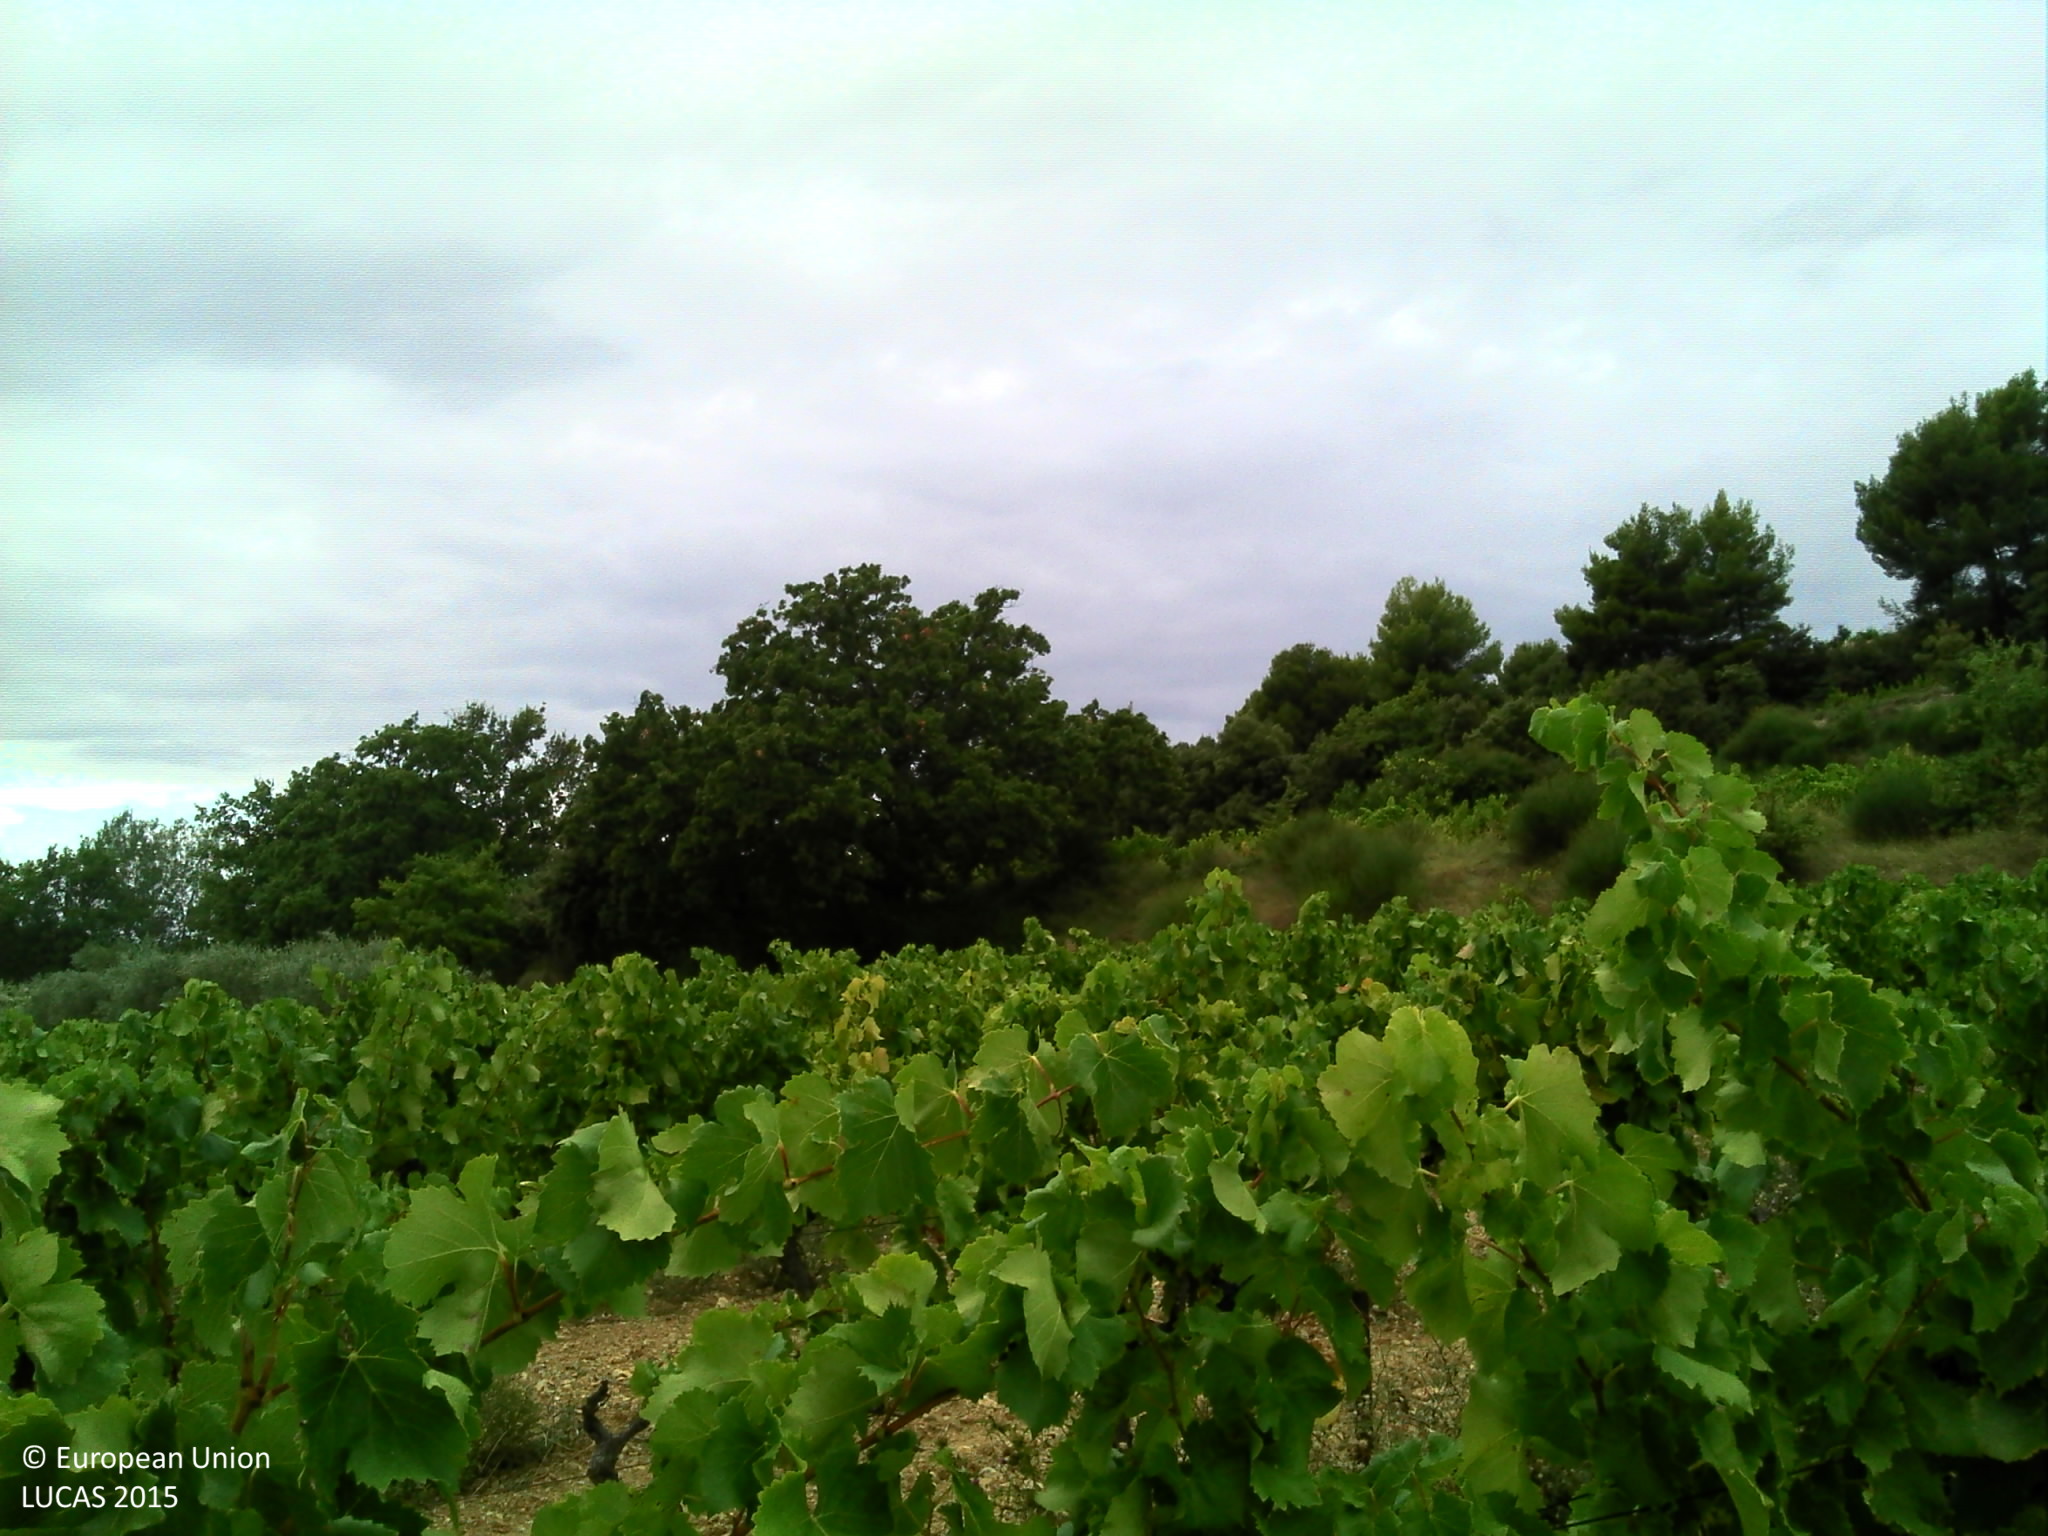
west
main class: Cropland
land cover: Vineyards
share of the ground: 50 - 75 %
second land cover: Grassland without tree/shrub cover
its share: 10 - 25 %
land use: Agriculture (excluding fallow land and kitchen gardens)
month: September
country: FR
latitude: 44.3422
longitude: 5.0780
